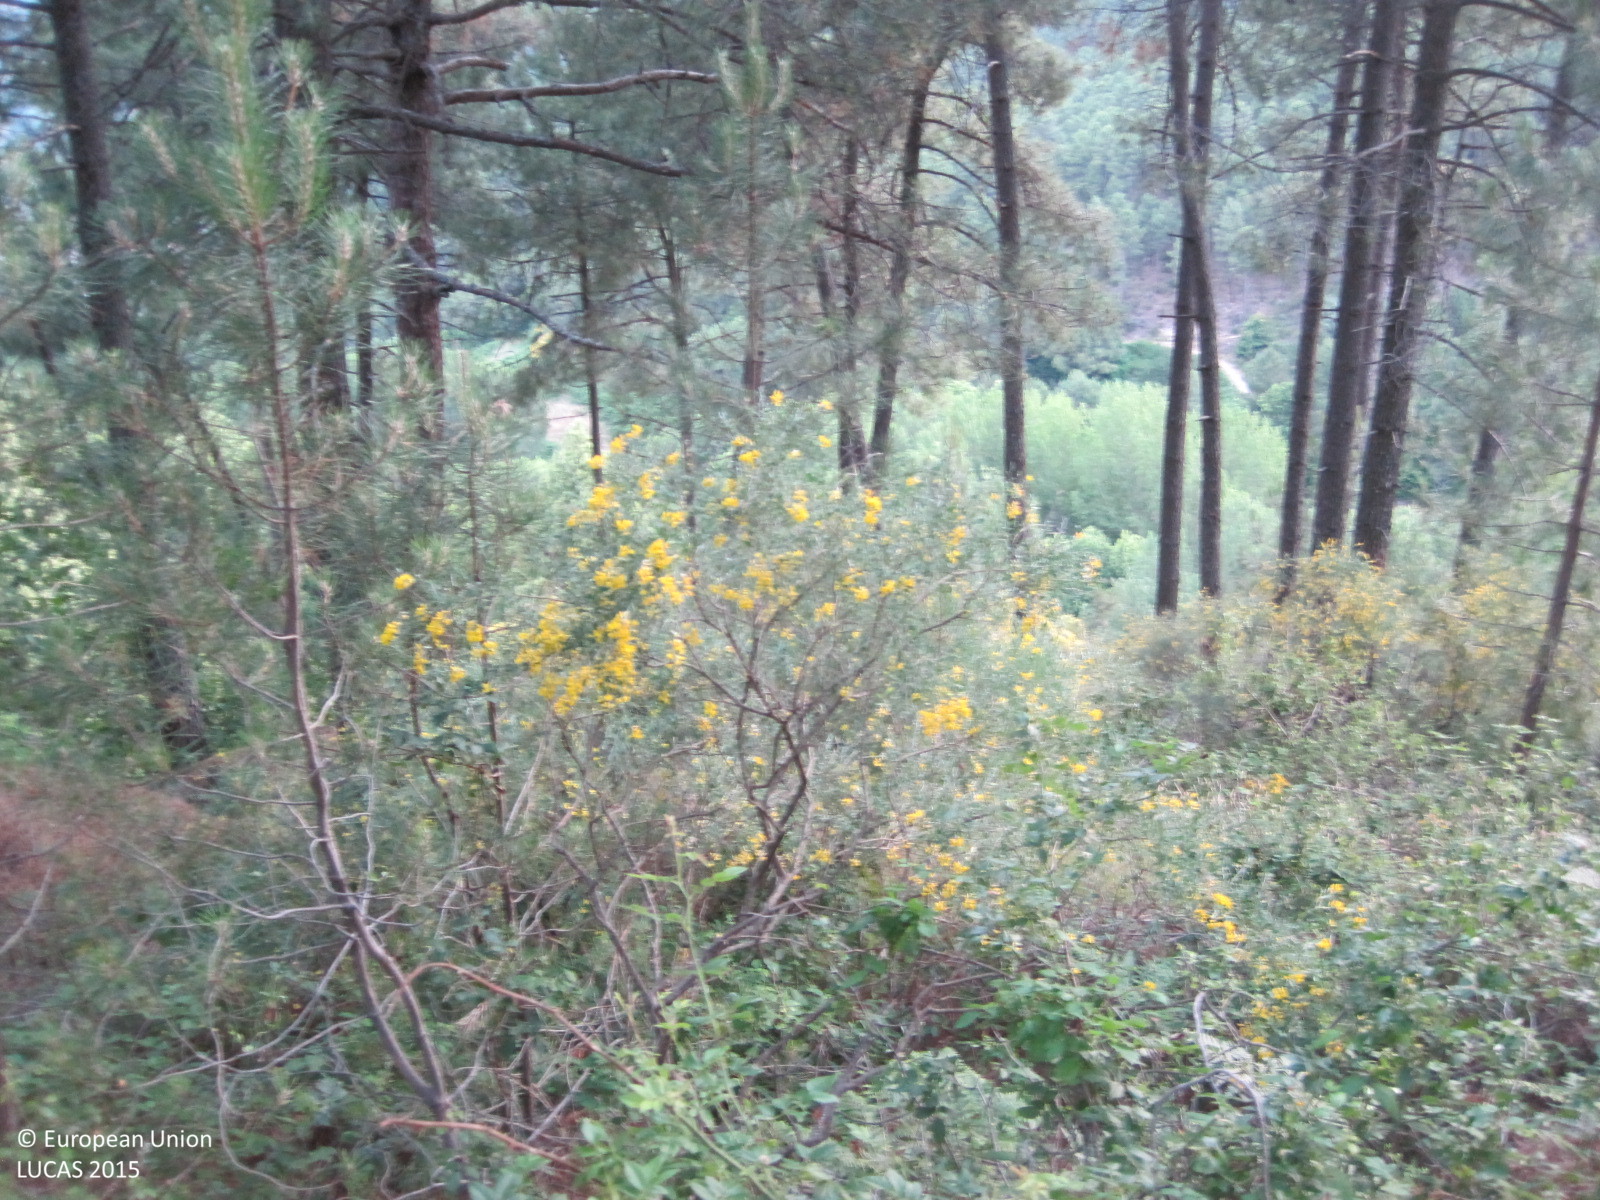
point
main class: Woodland
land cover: Pine dominated mixed woodland
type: coniferous forest of the mediterranean region
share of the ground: > 75 %
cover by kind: coniferous forest trees 50 %, broadleaved forest trees 50 %
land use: Semi-natural and natural areas not in use
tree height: > 5 m
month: June
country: ES
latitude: 40.2460
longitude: -4.9960
